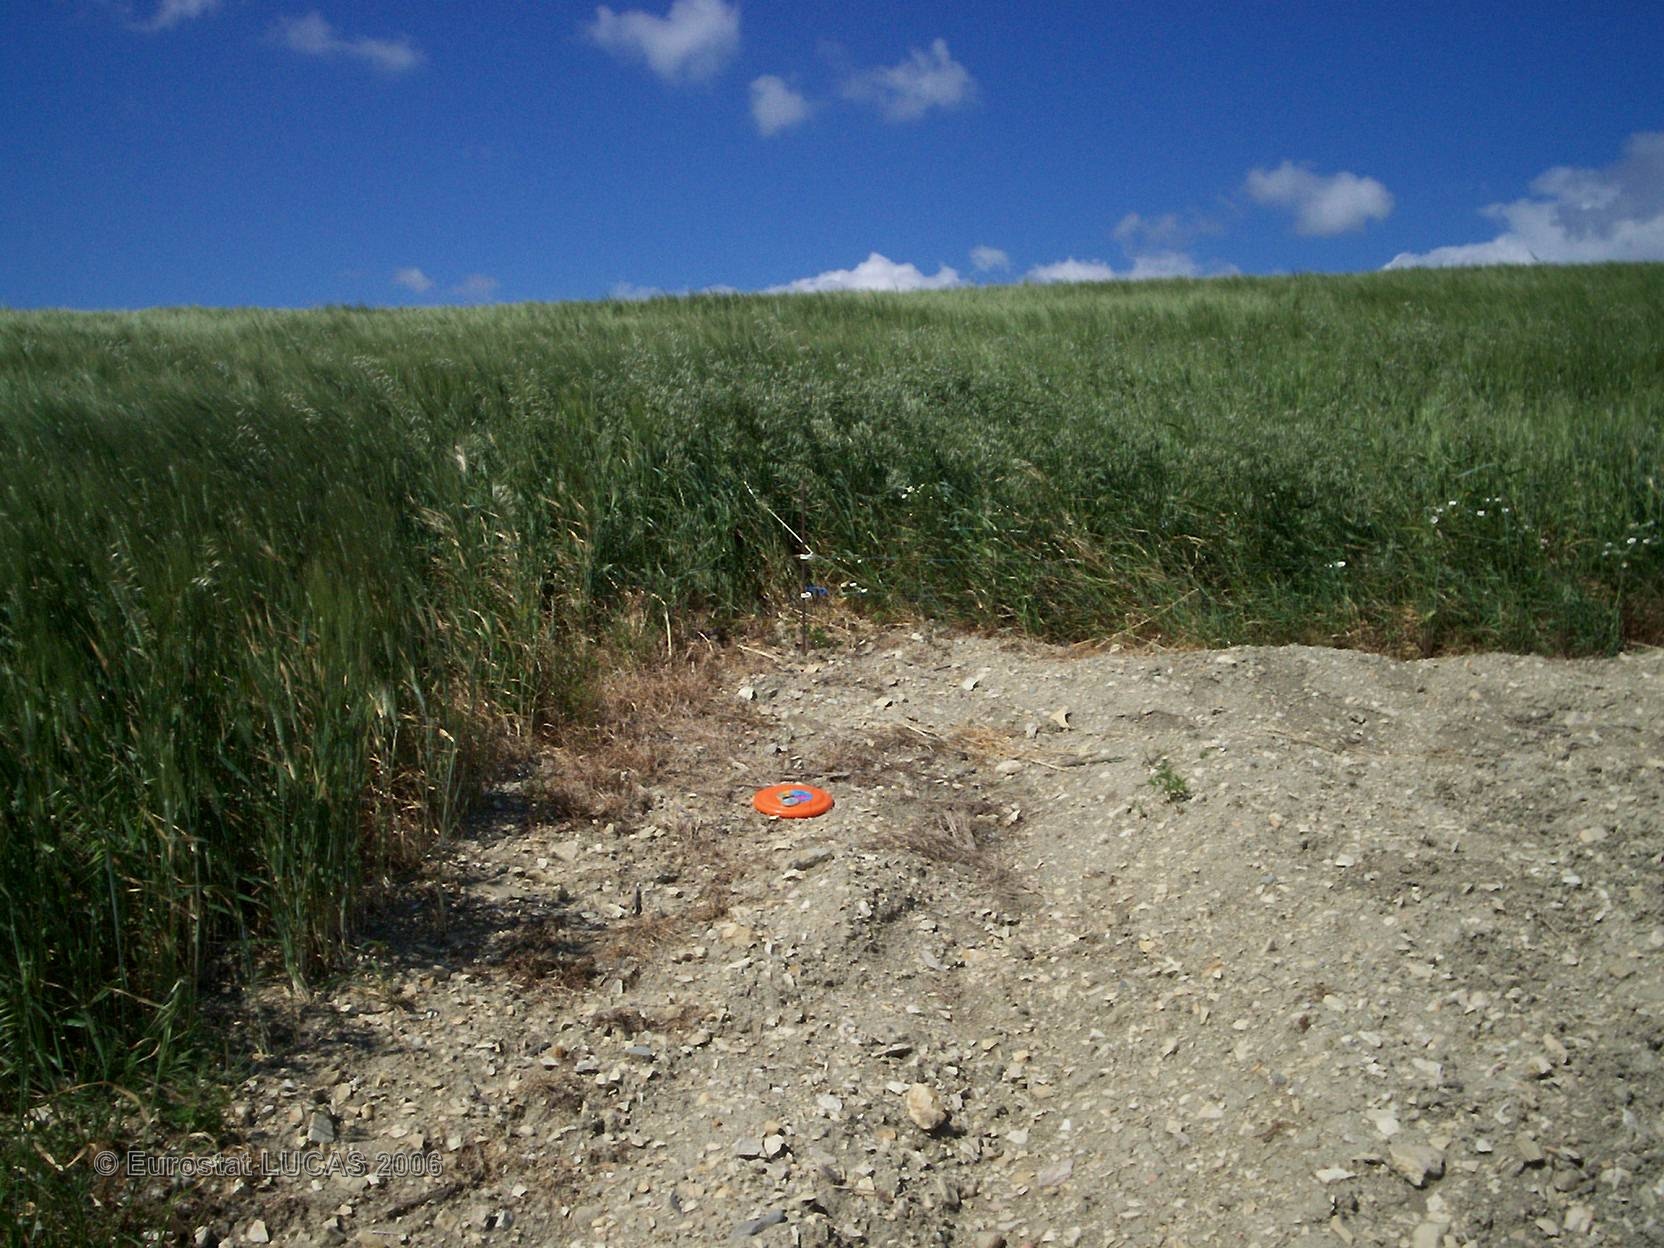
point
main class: Cropland
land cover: Maize
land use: Agriculture (excluding fallow land and kitchen gardens)
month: May
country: FR
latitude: 44.6587
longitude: 4.8989
